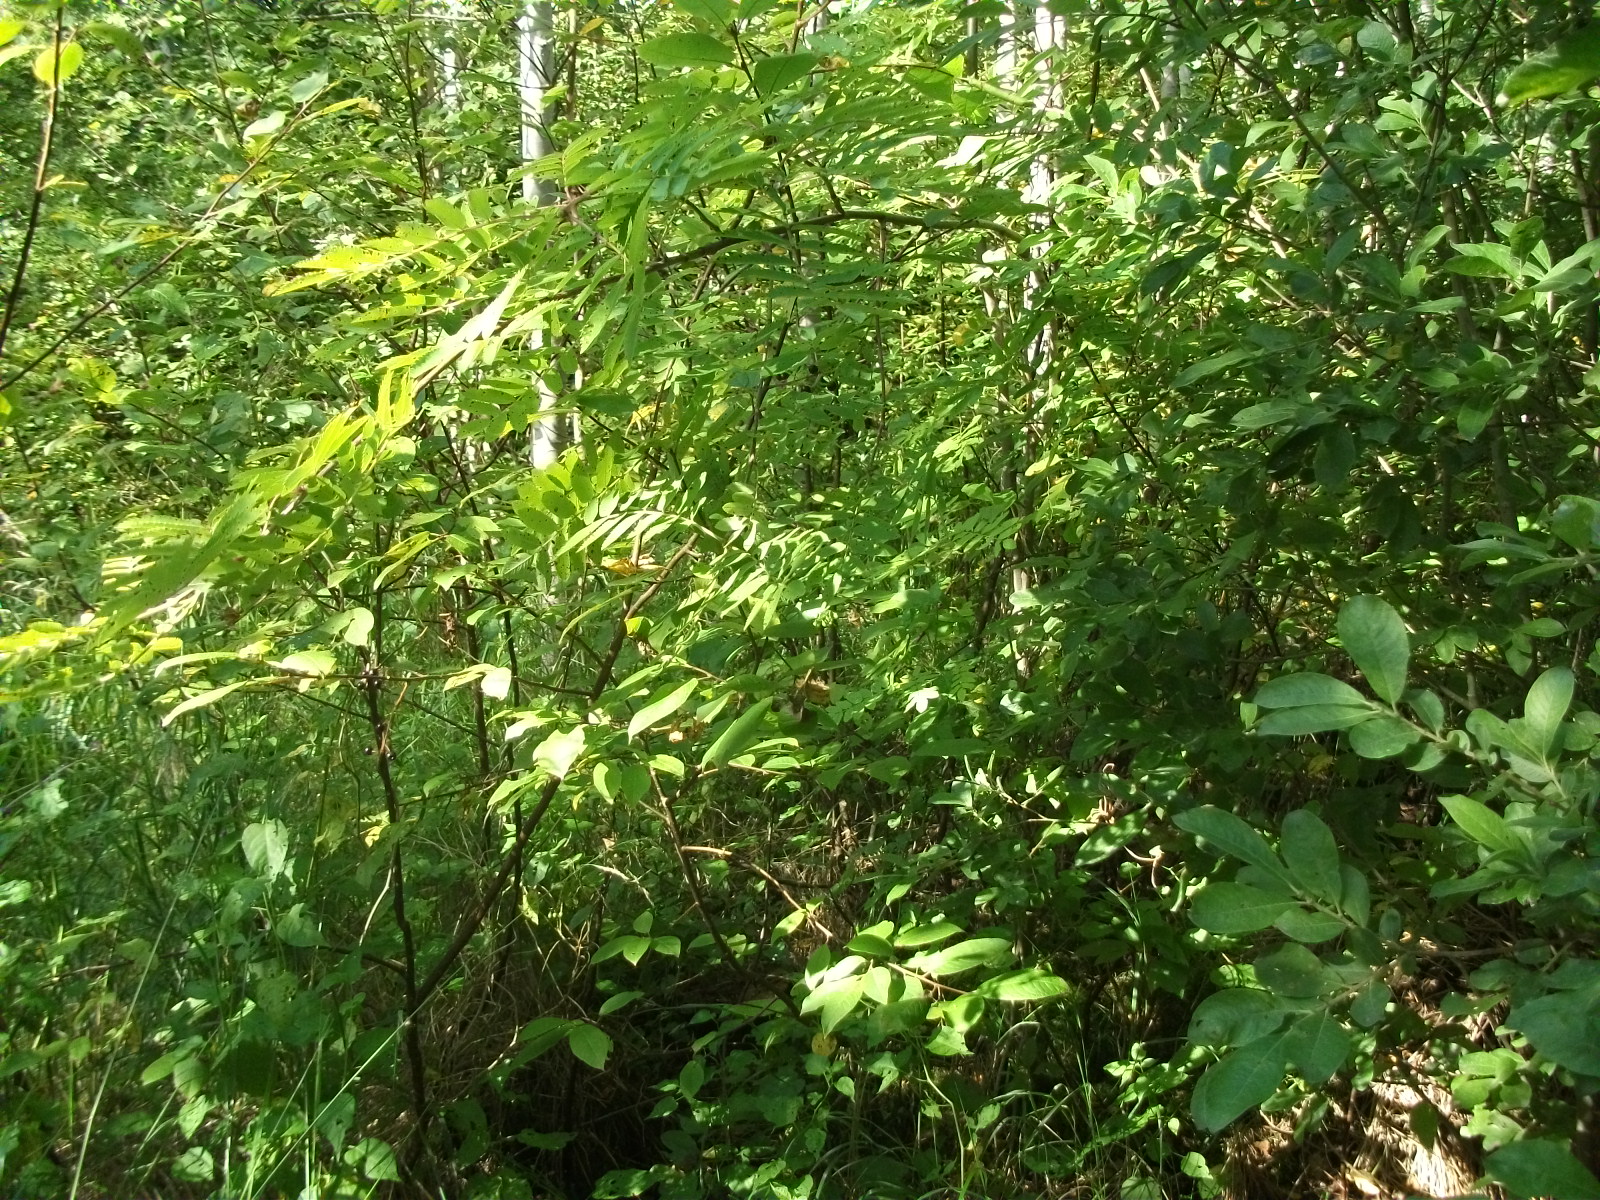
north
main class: Woodland
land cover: Broadleaved woodland
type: non-riverine alder, birch or aspen forest
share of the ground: > 75 %
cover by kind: broadleaved forest trees 85 %, coniferous forest trees 5 %, shrubs 5 %, herbaceous plants 5 %
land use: Forestry
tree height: > 5 m
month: August
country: LV
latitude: 57.0664
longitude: 26.5903
